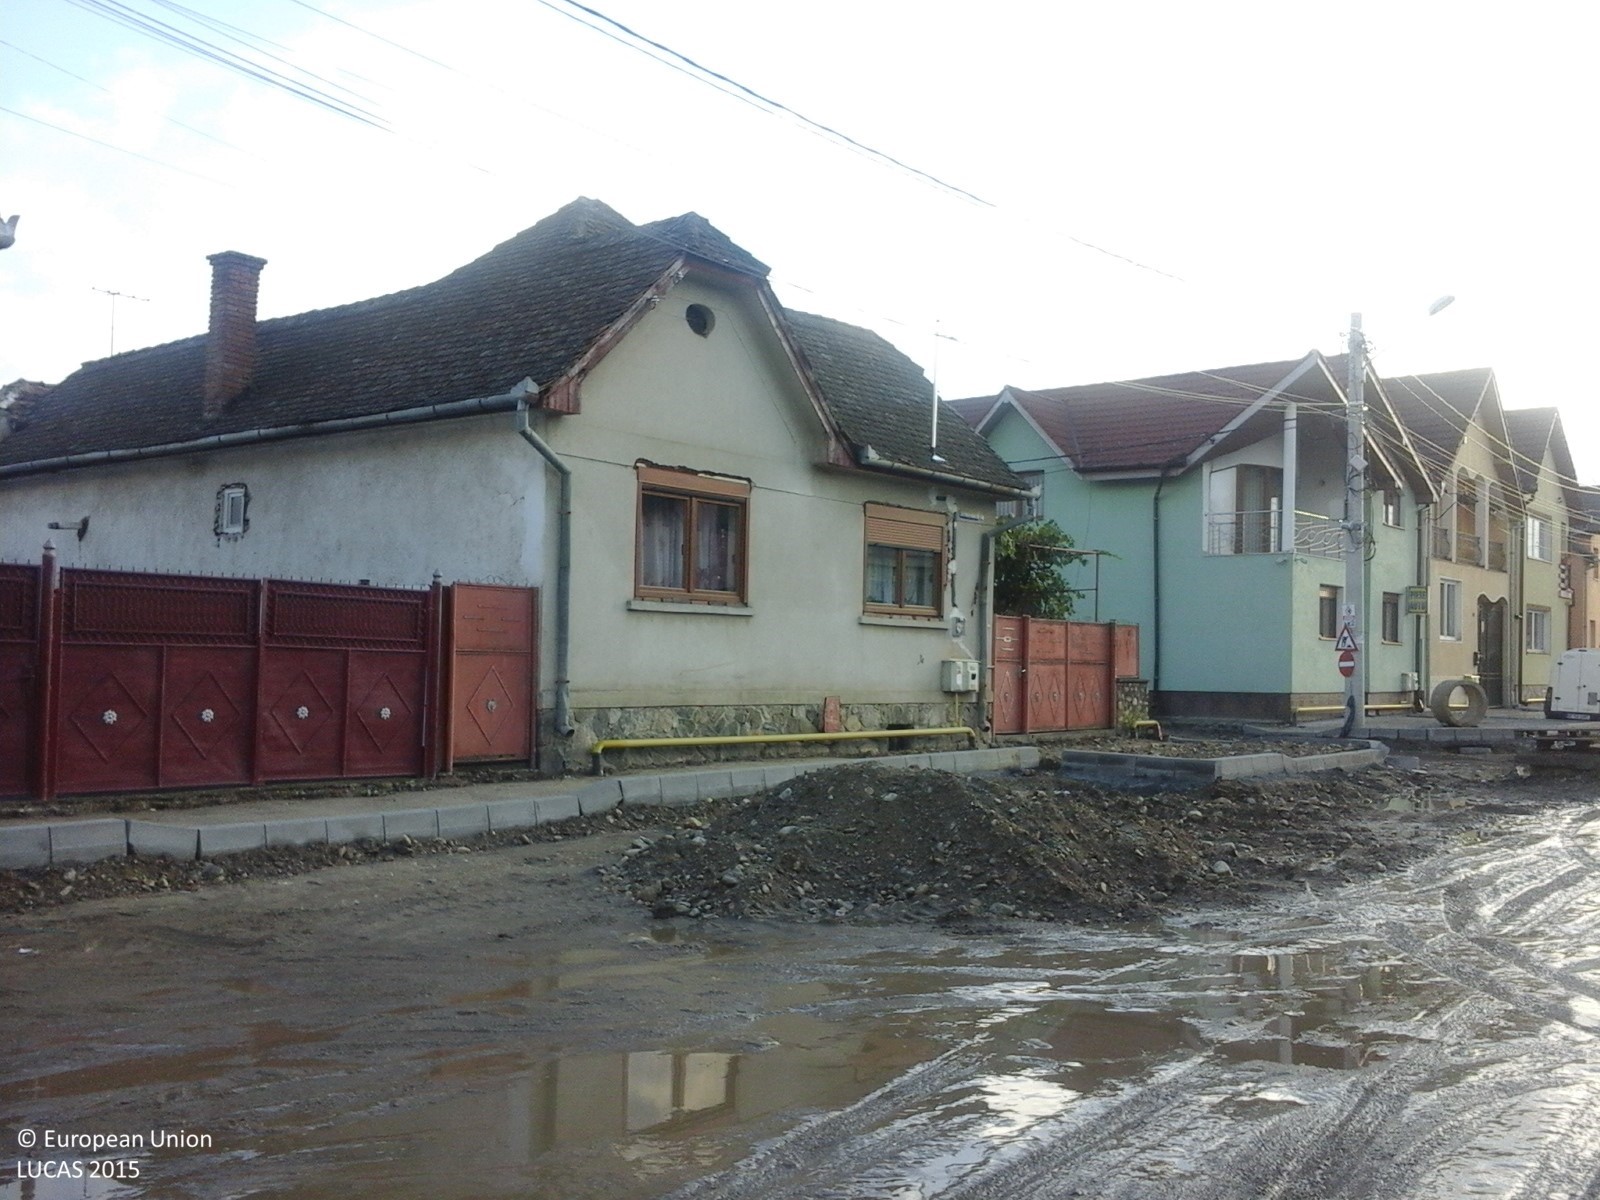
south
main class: Cropland
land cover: Vineyards
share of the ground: > 75 %
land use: Agriculture (excluding fallow land and kitchen gardens)
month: October
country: RO
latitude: 45.8082
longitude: 24.1395
